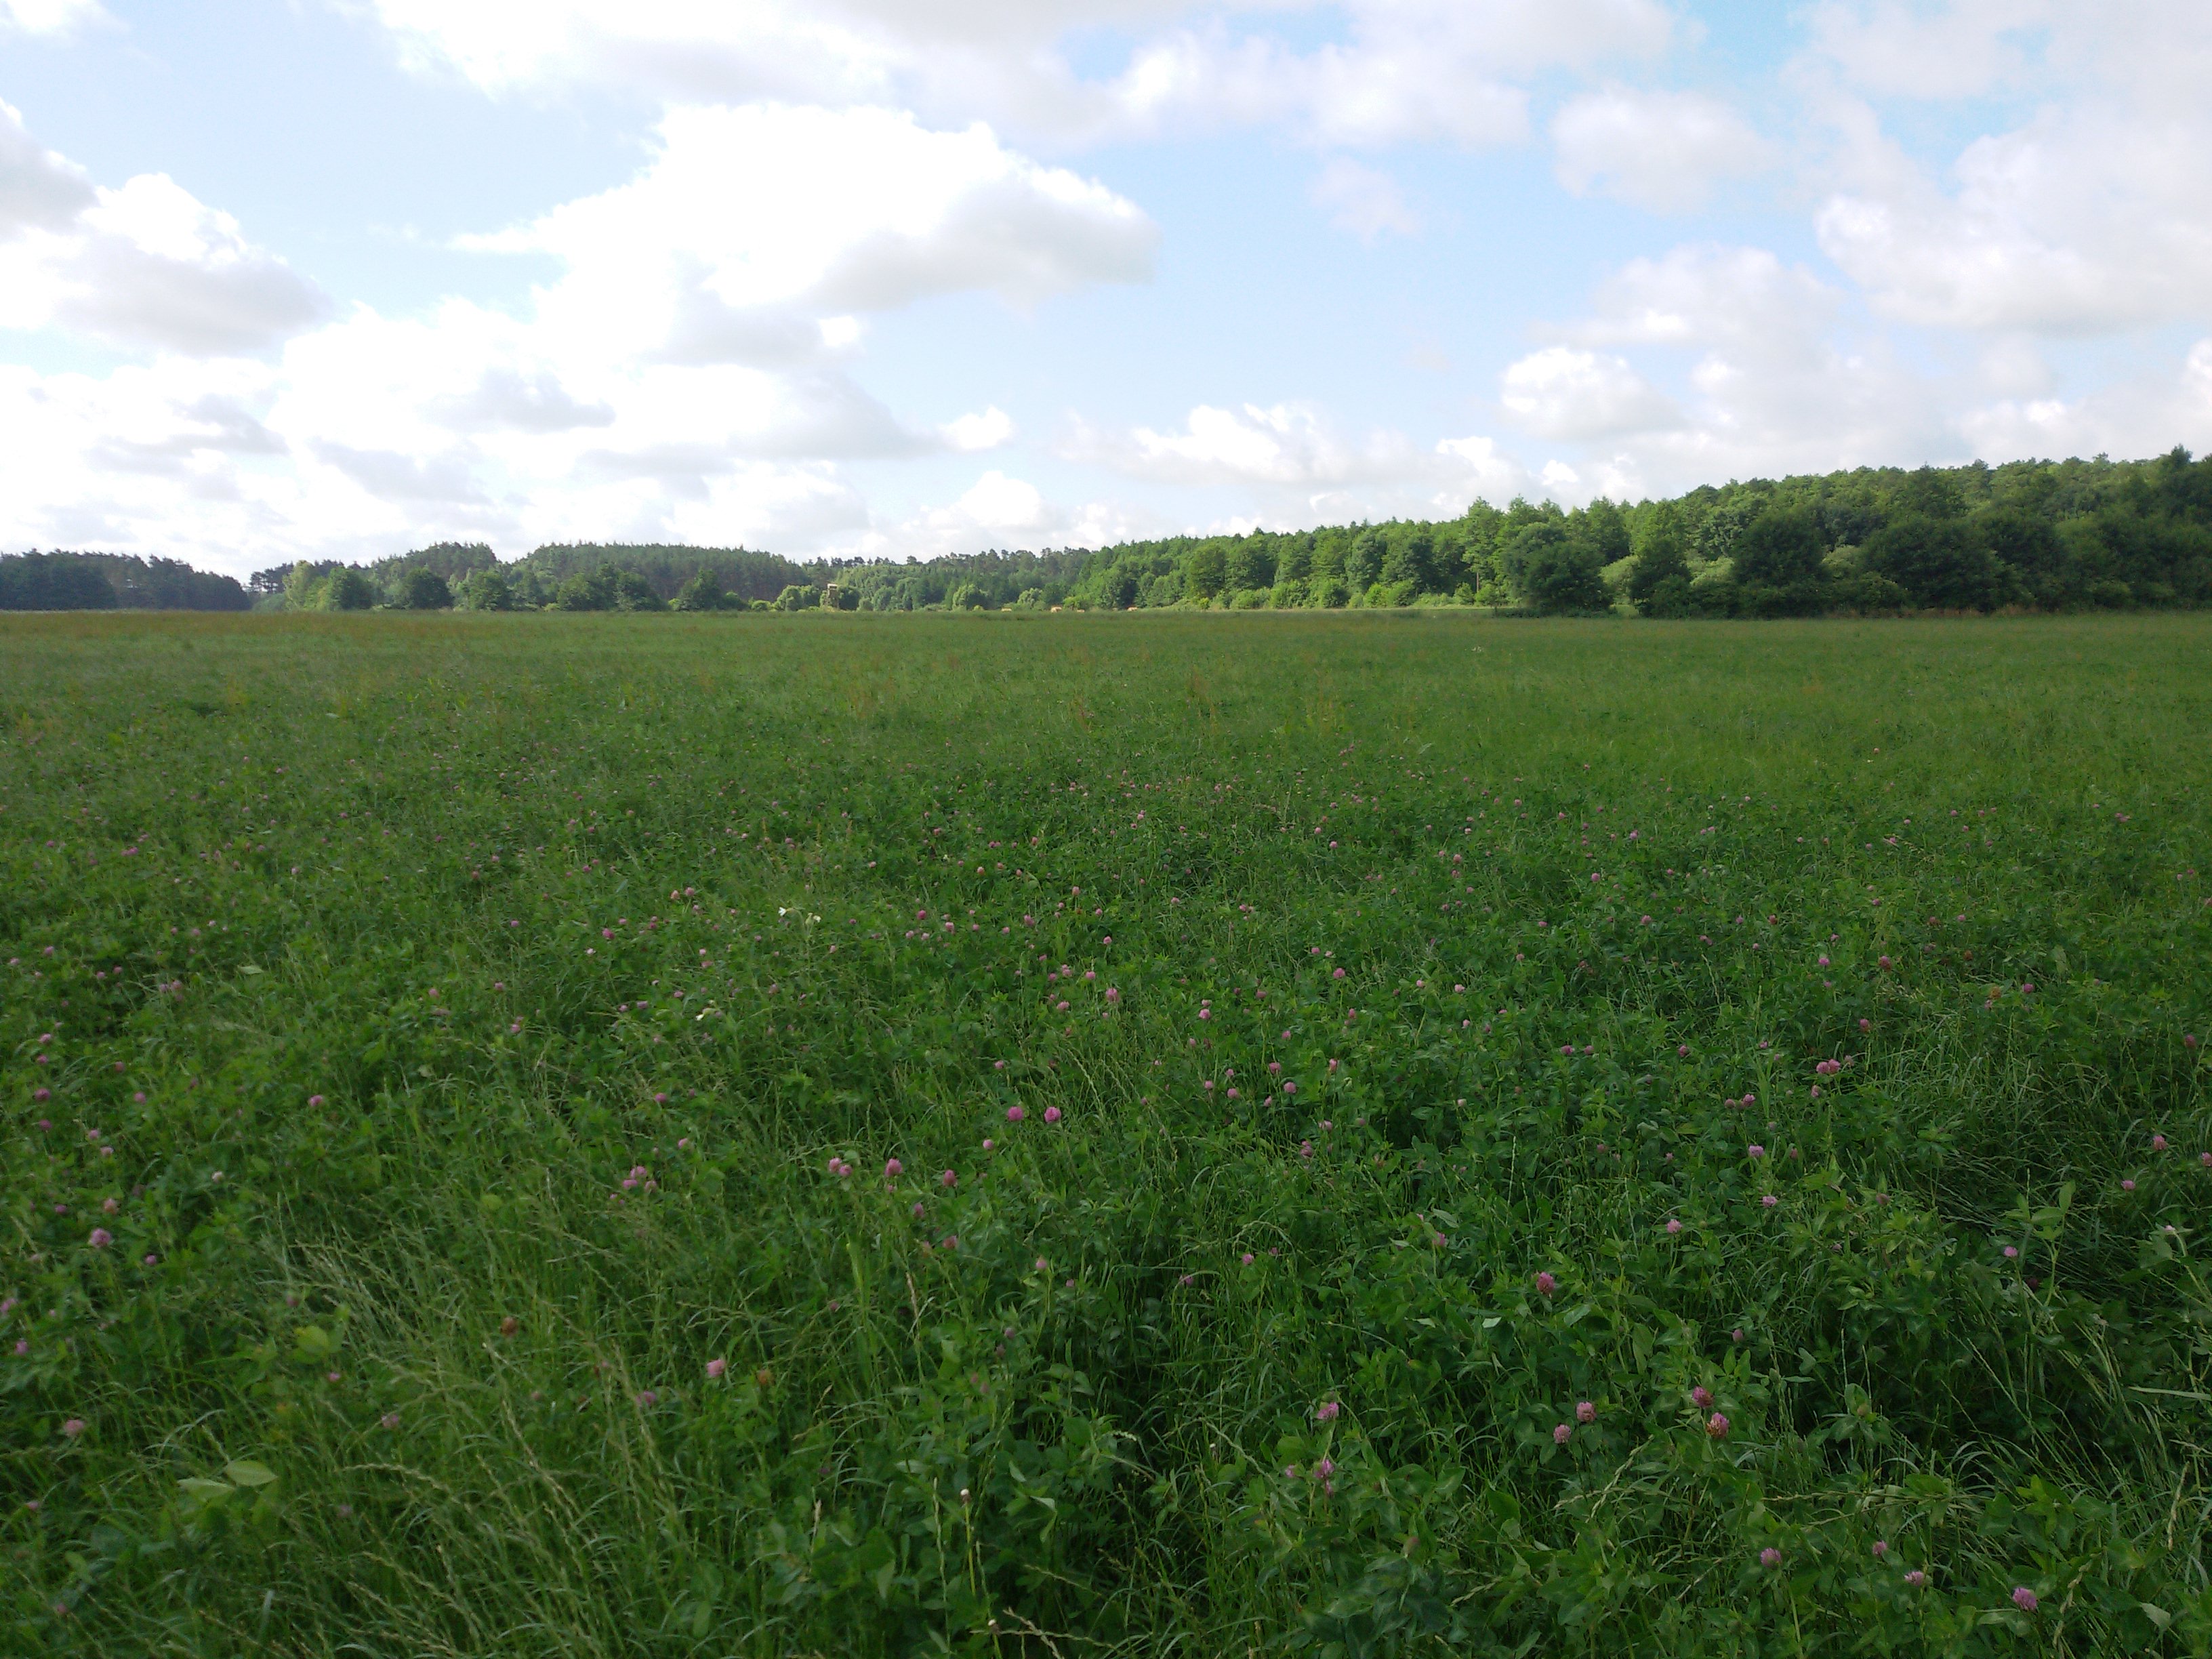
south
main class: Grassland
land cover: Grassland without tree/shrub cover
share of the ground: > 75 %
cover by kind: herbaceous plants 100 %
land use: Agriculture (excluding fallow land and kitchen gardens)
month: July
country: PL
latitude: 52.9828
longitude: 17.5941
